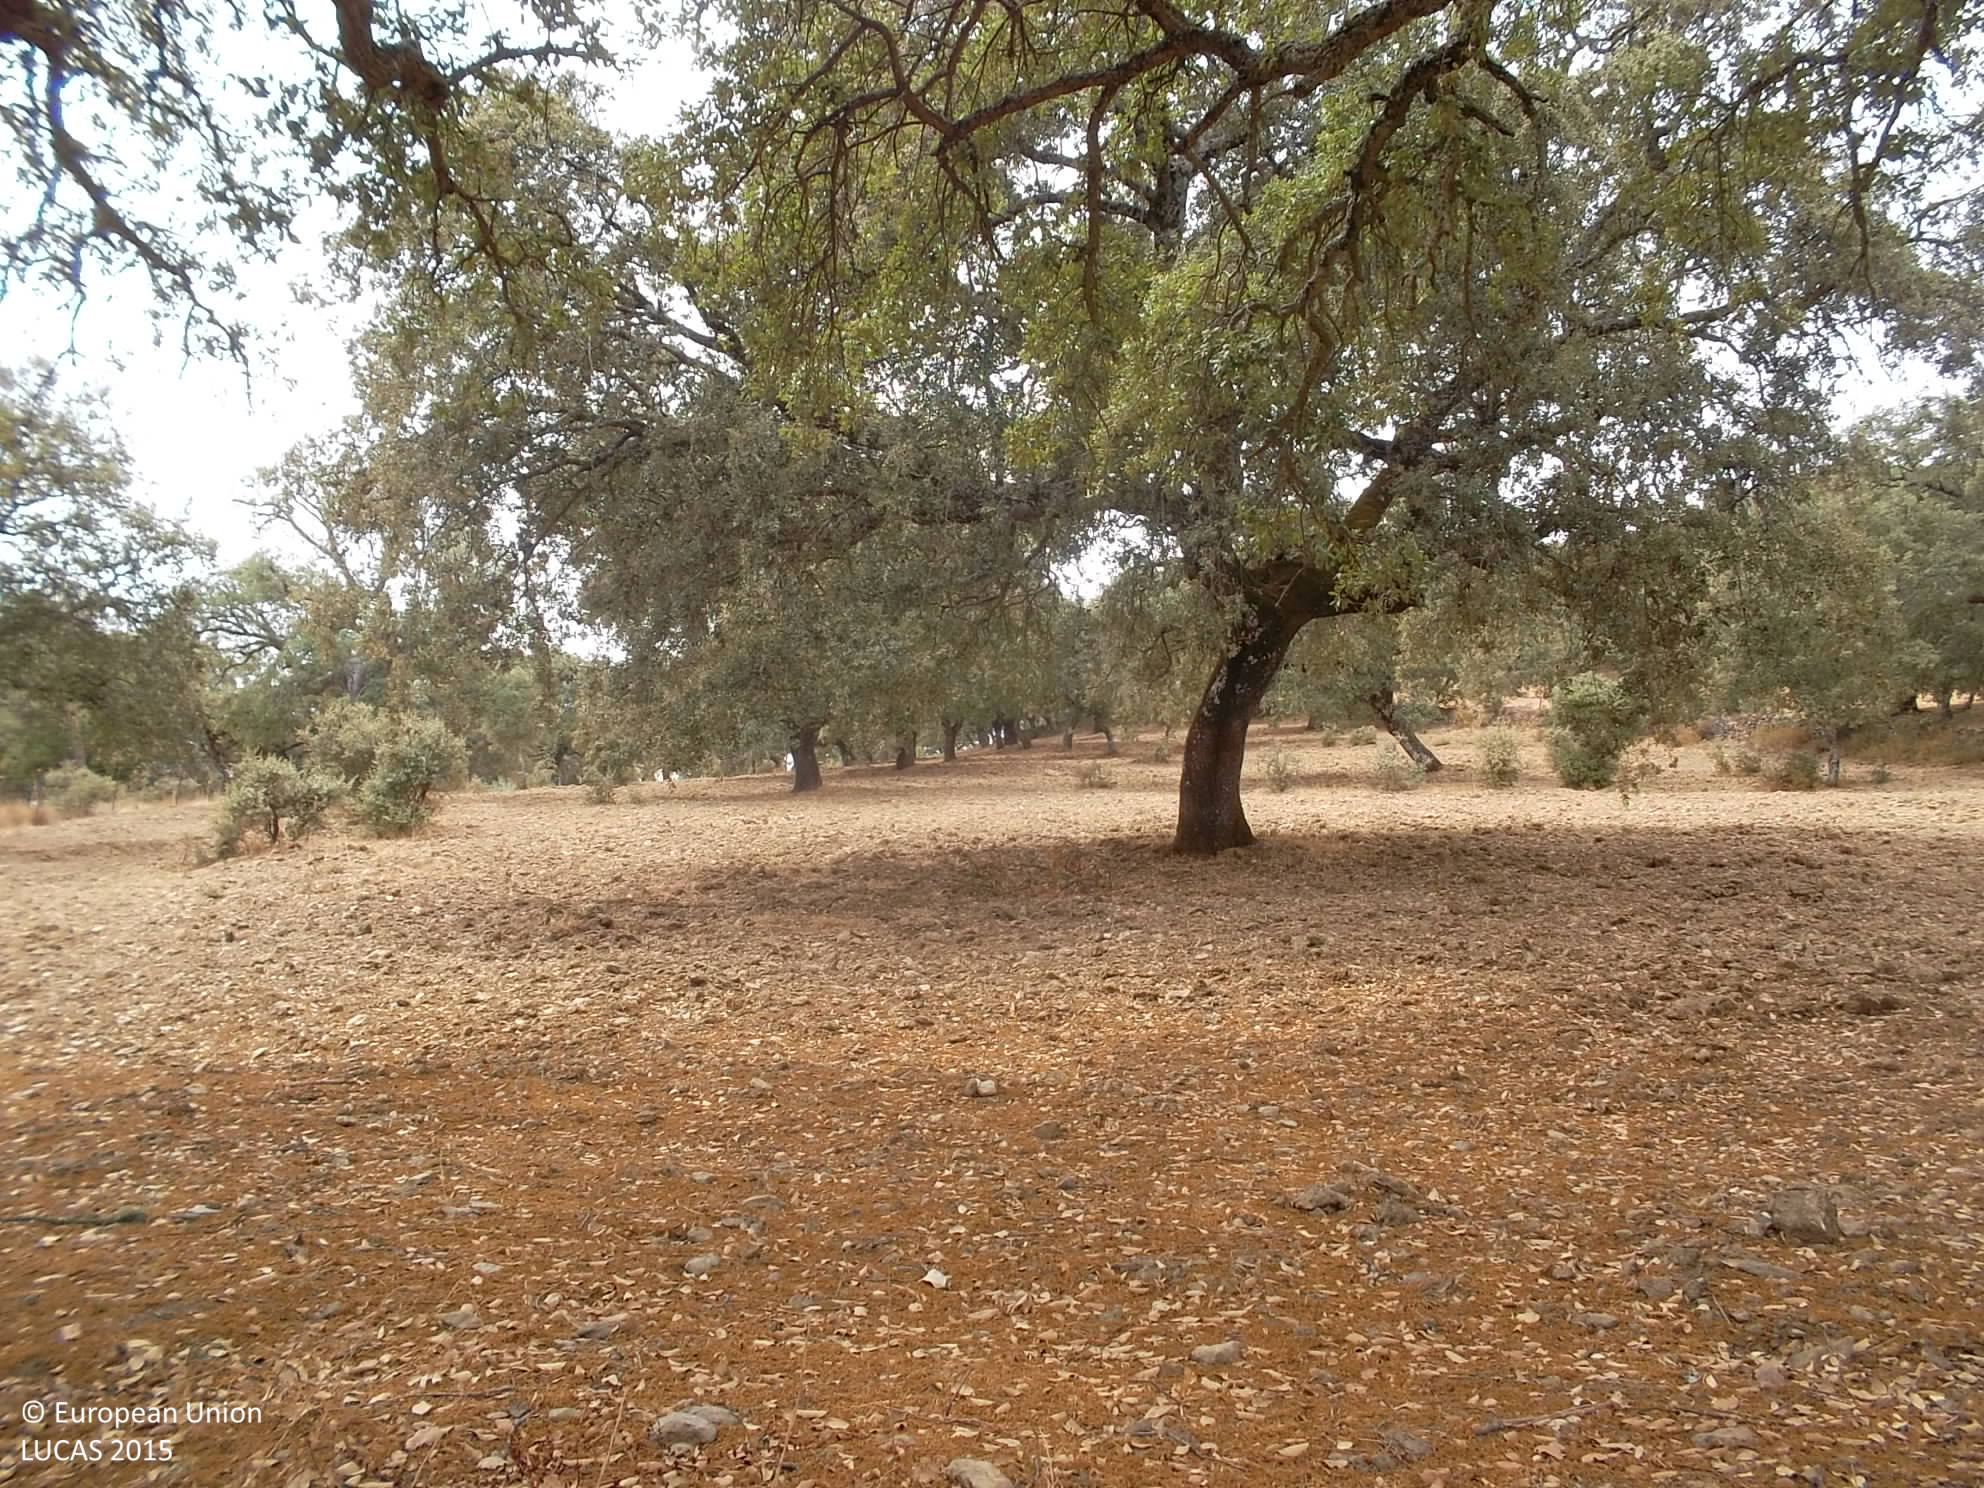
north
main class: Woodland
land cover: Broadleaved woodland
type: broadleaved evergreen forest
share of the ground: 25 - 50 %
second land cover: Grassland without tree/shrub cover
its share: > 75 %
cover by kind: herbaceous plants 75 %, broadleaved forest trees 25 %
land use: Forestry
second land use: Agriculture (excluding fallow land and kitchen gardens)
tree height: > 5 m
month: September
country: ES
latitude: 38.0774
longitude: -6.3331
